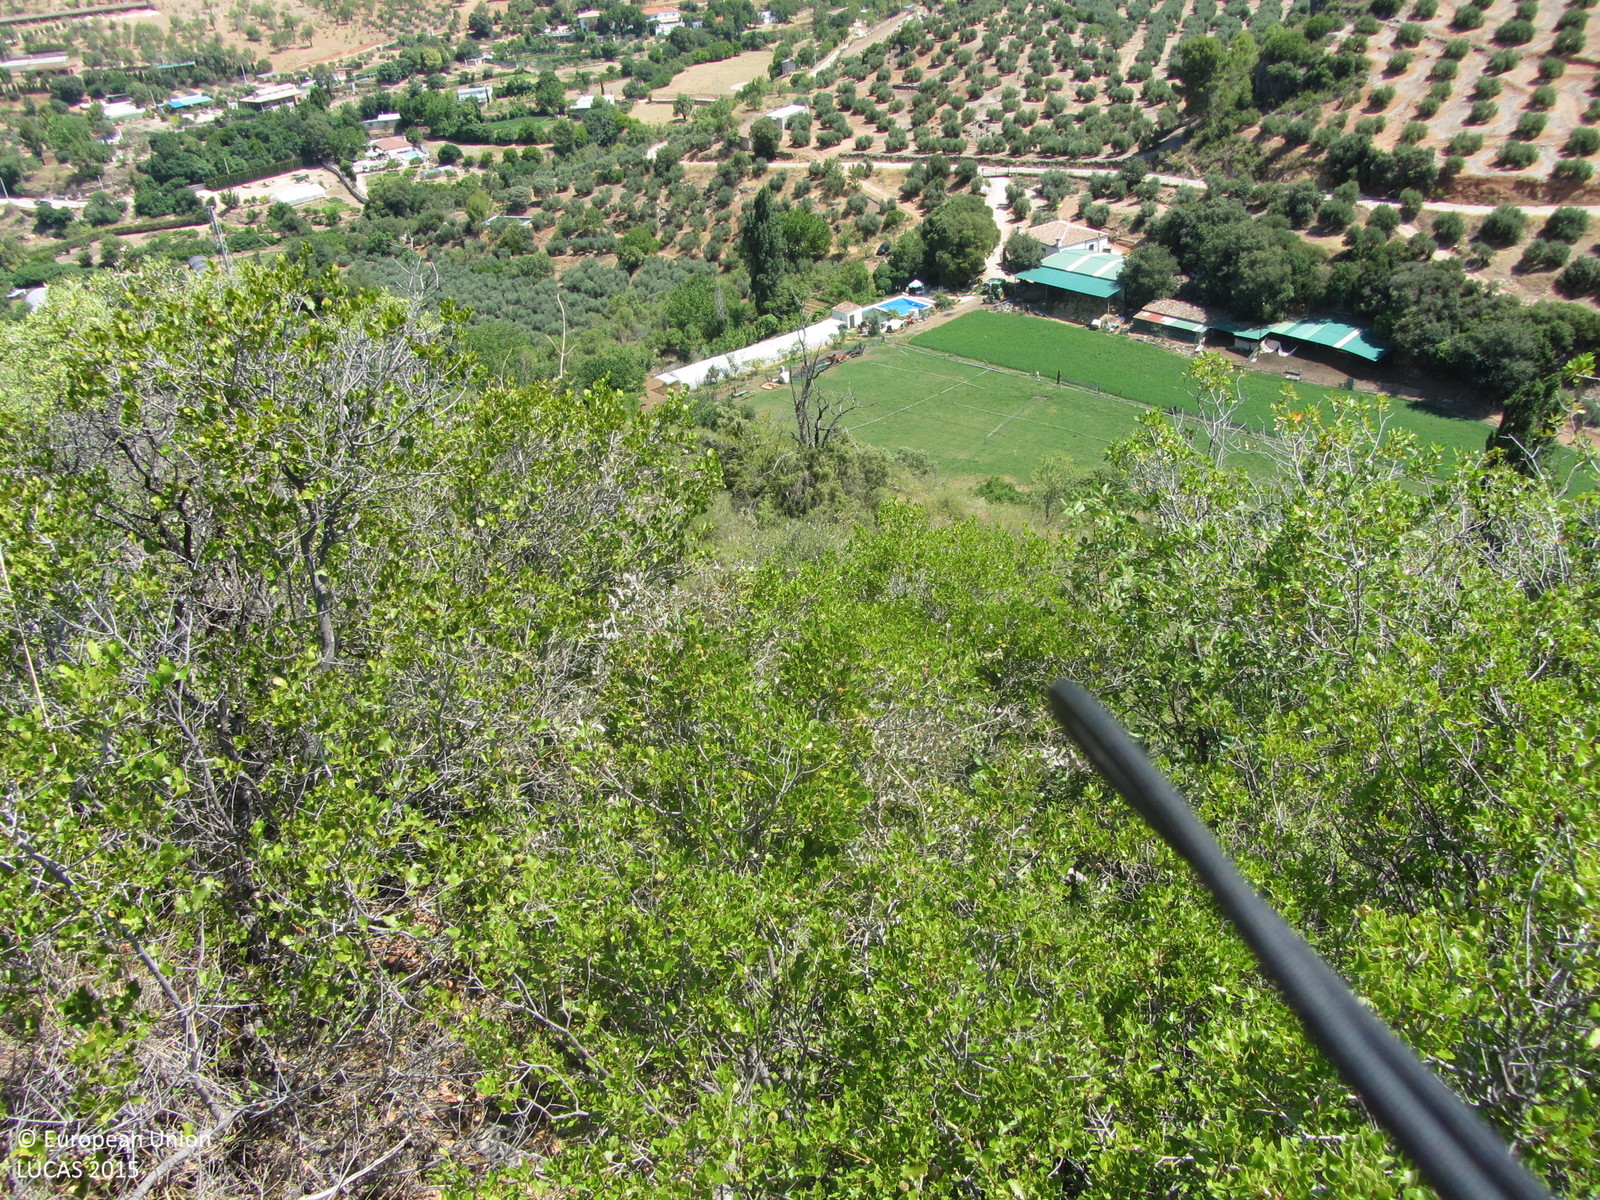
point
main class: Shrubland
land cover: Shrubland with sparse tree cover
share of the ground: > 75 %
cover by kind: shrubs 95 %, coniferous forest trees 5 %
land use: Semi-natural and natural areas not in use
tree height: < 5 m
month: June
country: ES
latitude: 38.2432
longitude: -2.8757
